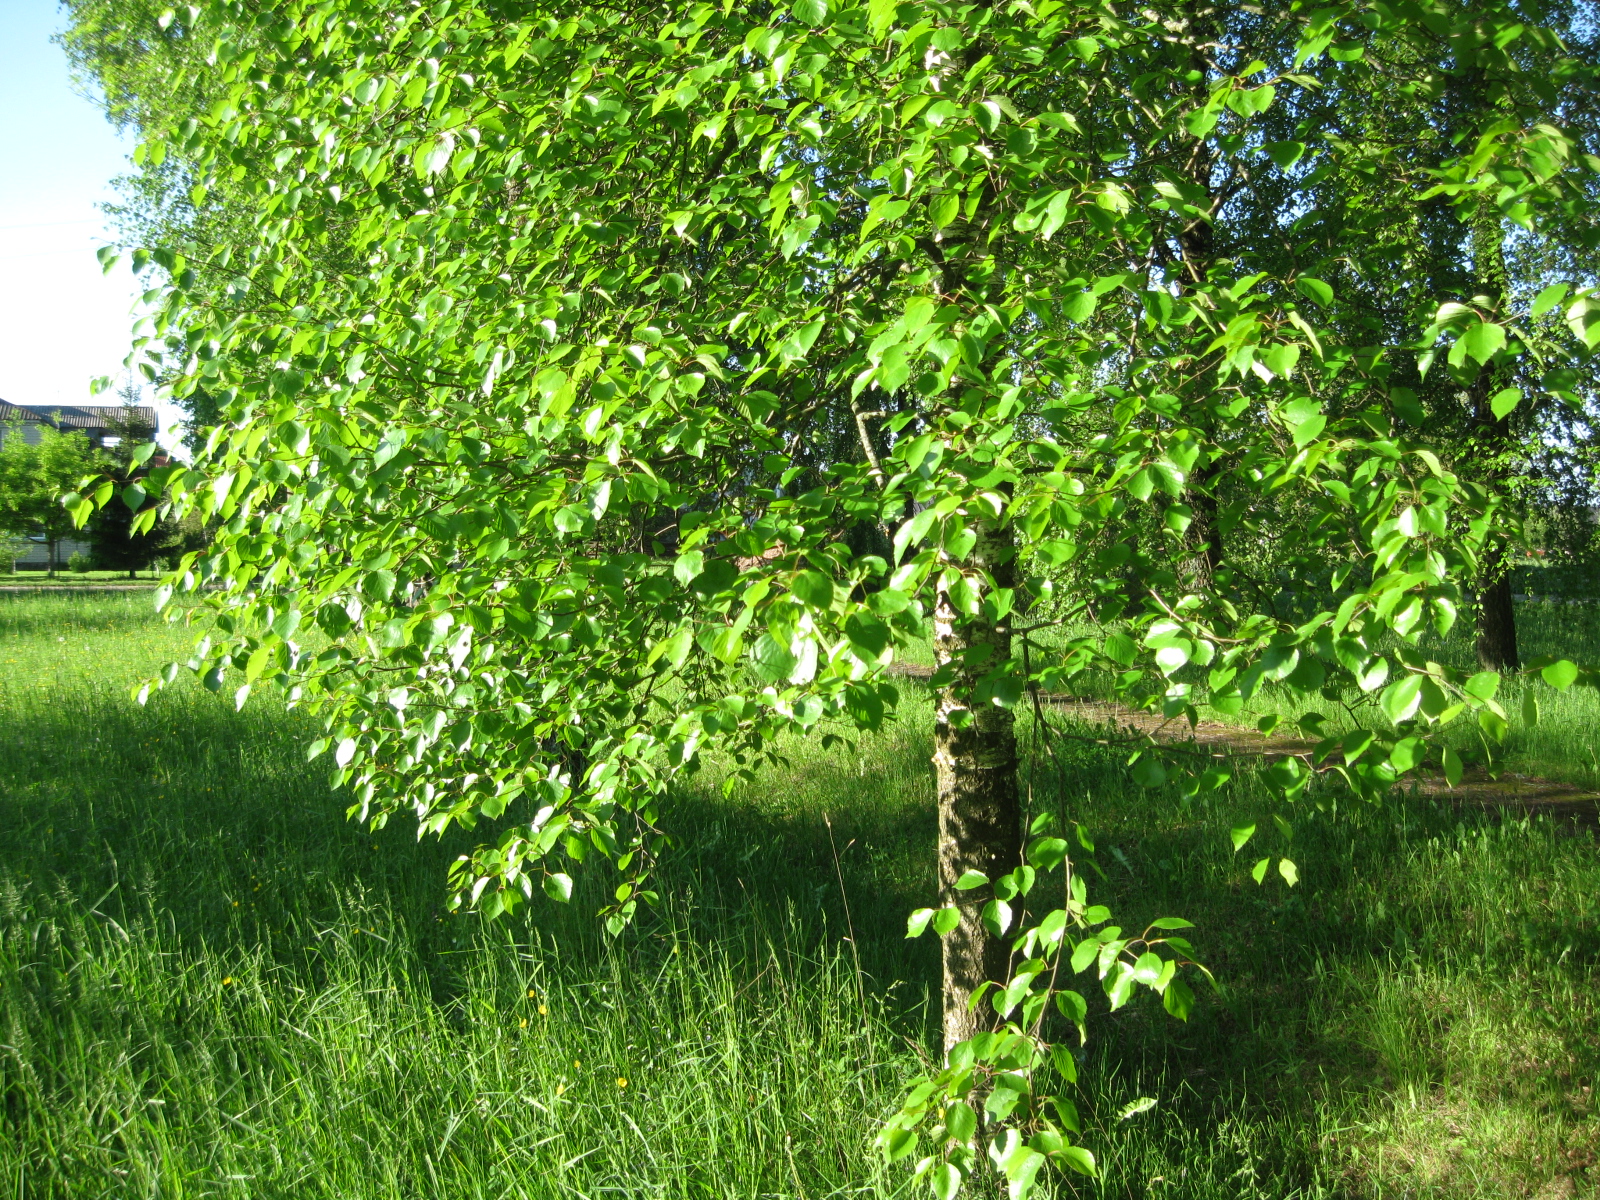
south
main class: Woodland
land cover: Broadleaved woodland
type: non-riverine alder, birch or aspen forest
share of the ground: 50 - 75 %
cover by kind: broadleaved forest trees 55 %, herbaceous plants 45 %
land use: Amenities, museums, leisure
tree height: > 5 m
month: May
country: LT
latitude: 55.9081
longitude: 24.8066
